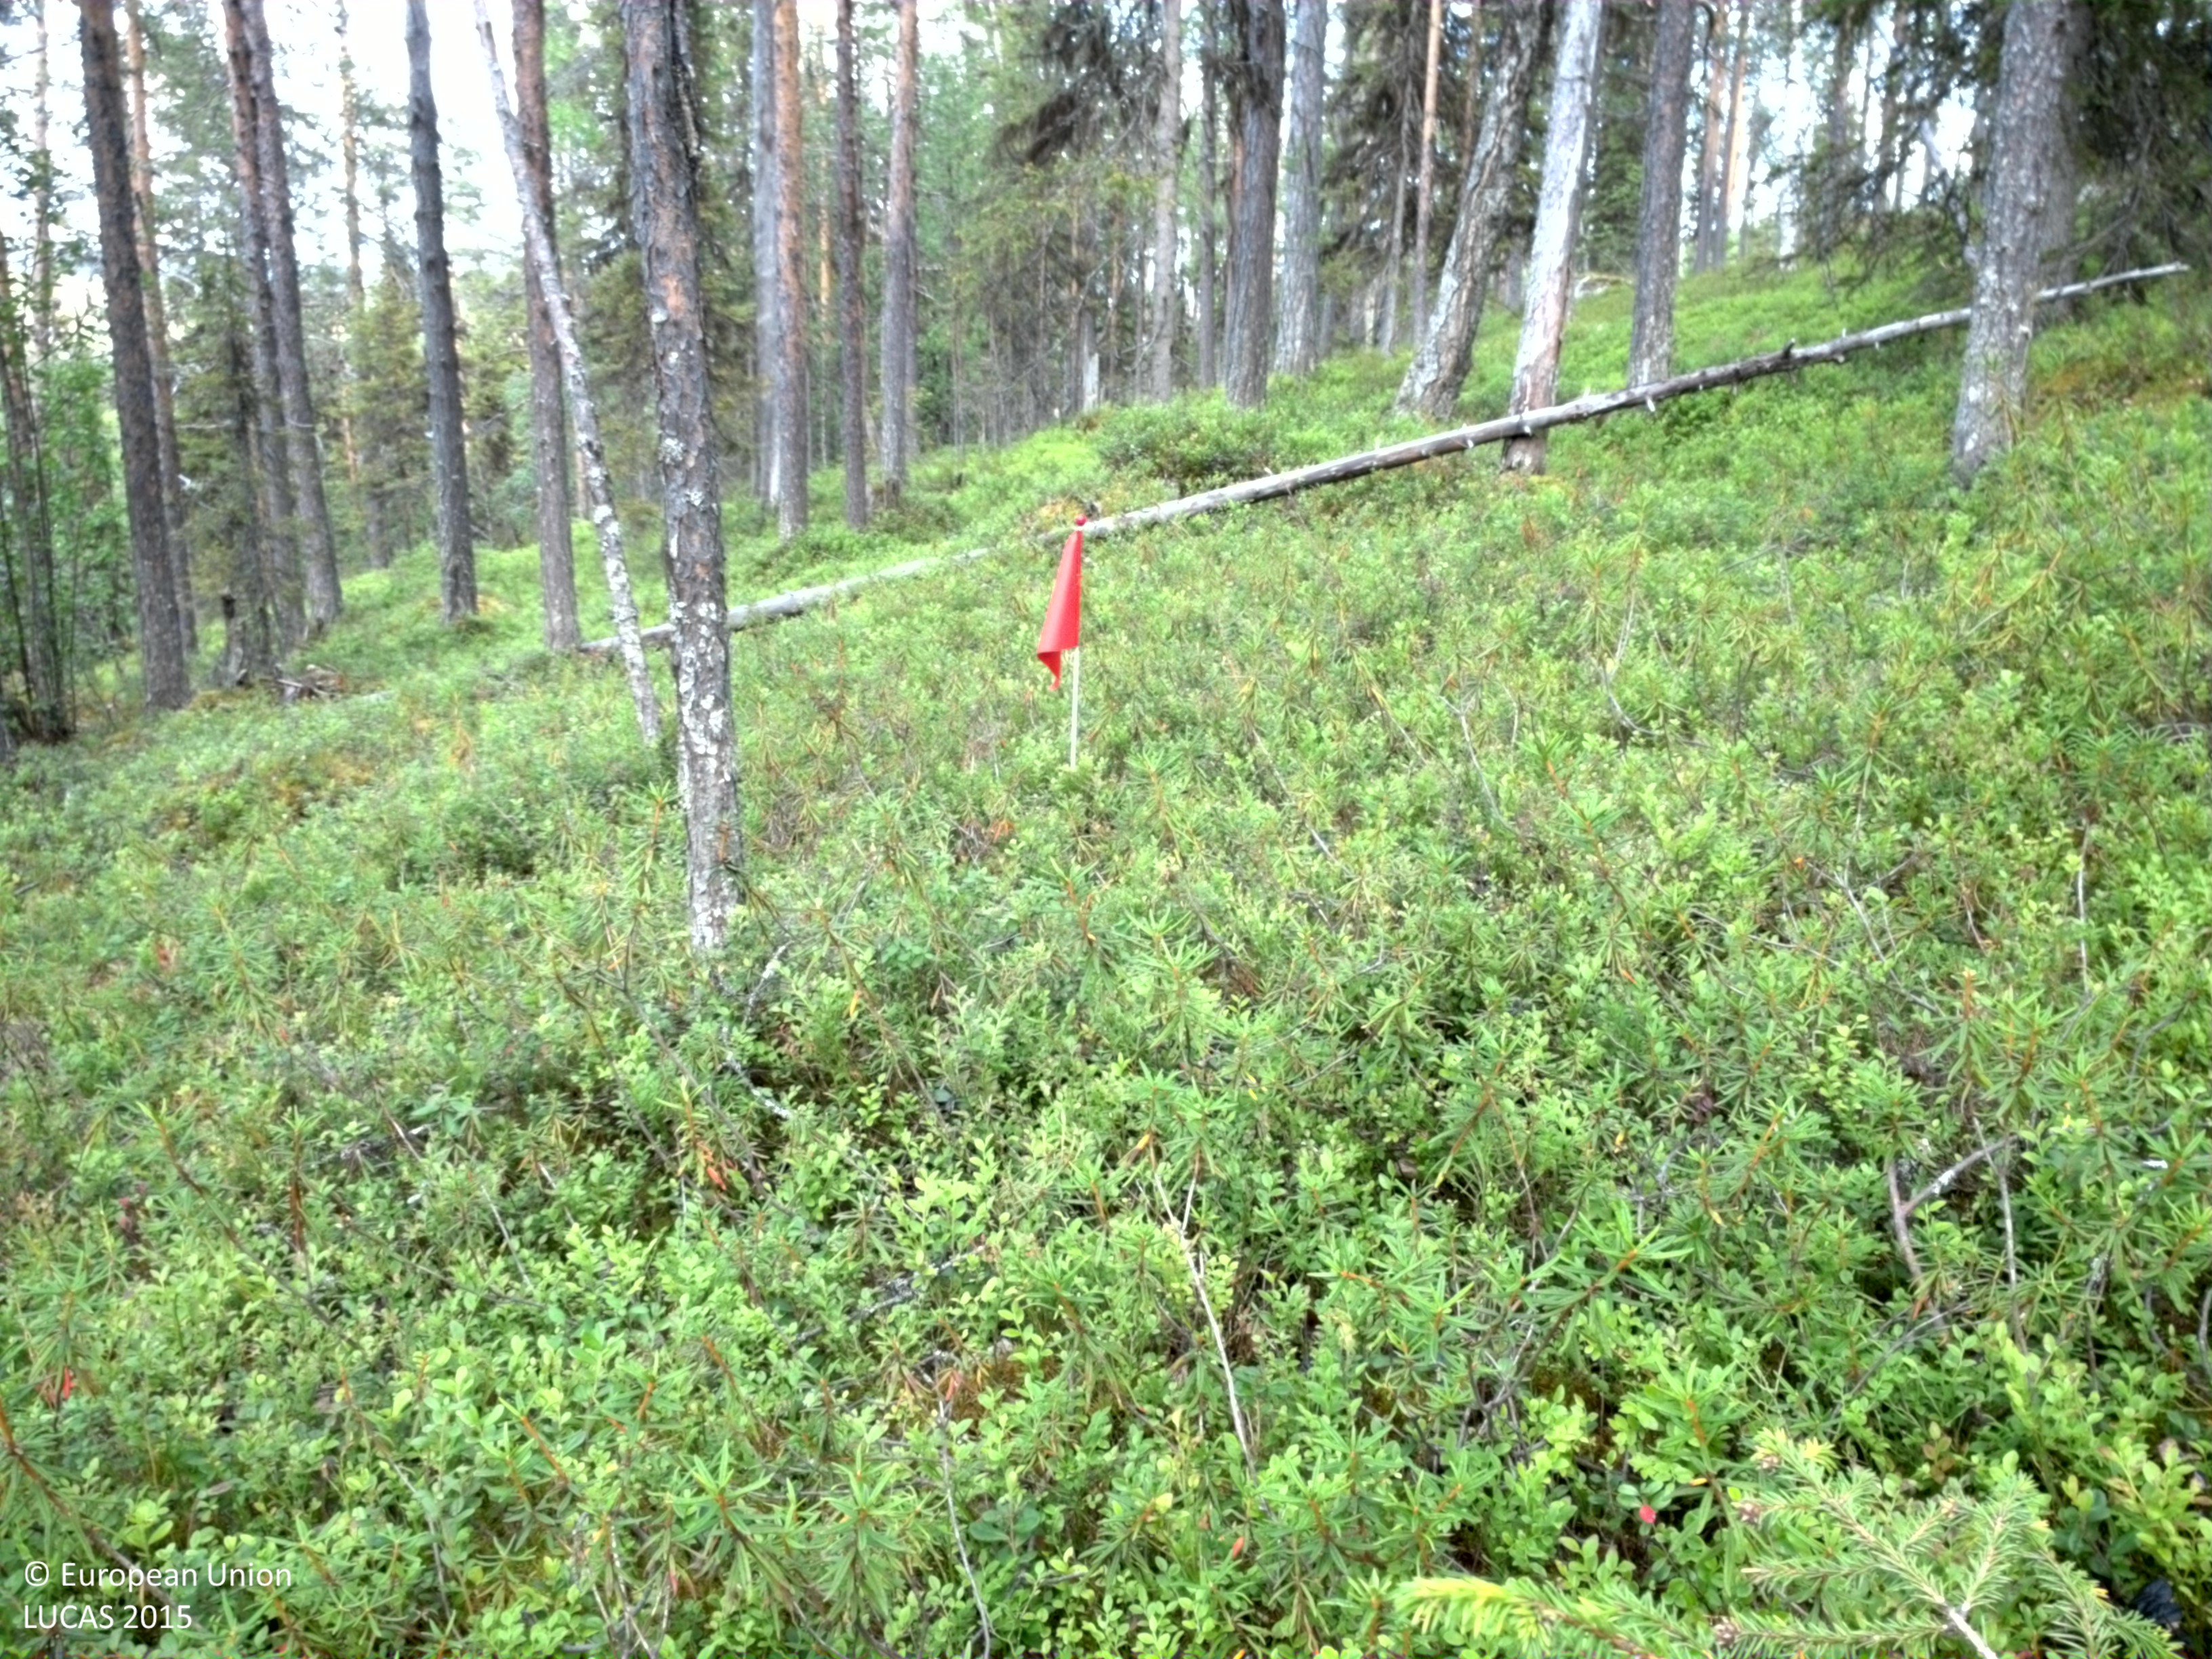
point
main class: Woodland
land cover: Pine dominated coniferous woodland
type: boreal forest
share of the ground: 25 - 50 %
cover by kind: shrubs 65 %, coniferous forest trees 30 %, broadleaved forest trees 5 %
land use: Forestry
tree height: > 5 m
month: August
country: SE
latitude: 66.5626
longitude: 20.0246
